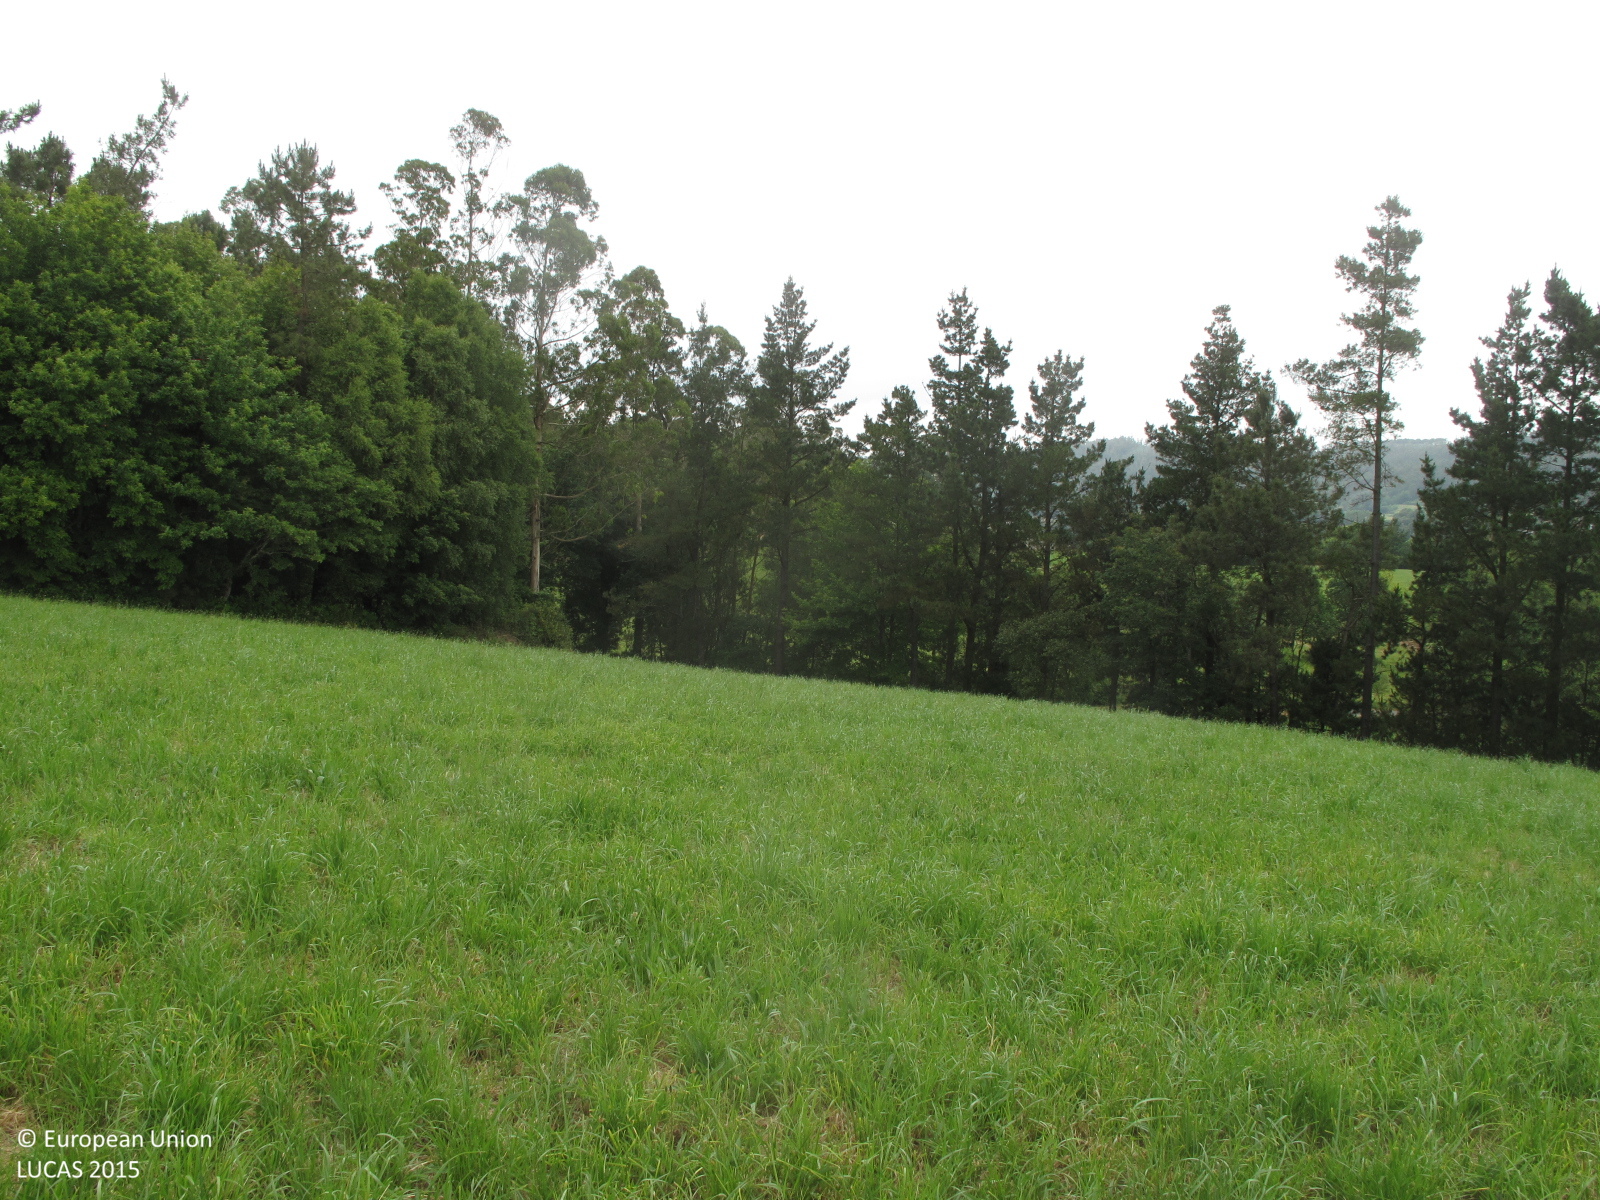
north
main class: Grassland
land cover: Grassland without tree/shrub cover
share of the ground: > 75 %
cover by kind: herbaceous plants 100 %
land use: Agriculture (excluding fallow land and kitchen gardens)
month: June
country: ES
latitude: 43.1508
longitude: -8.5921
